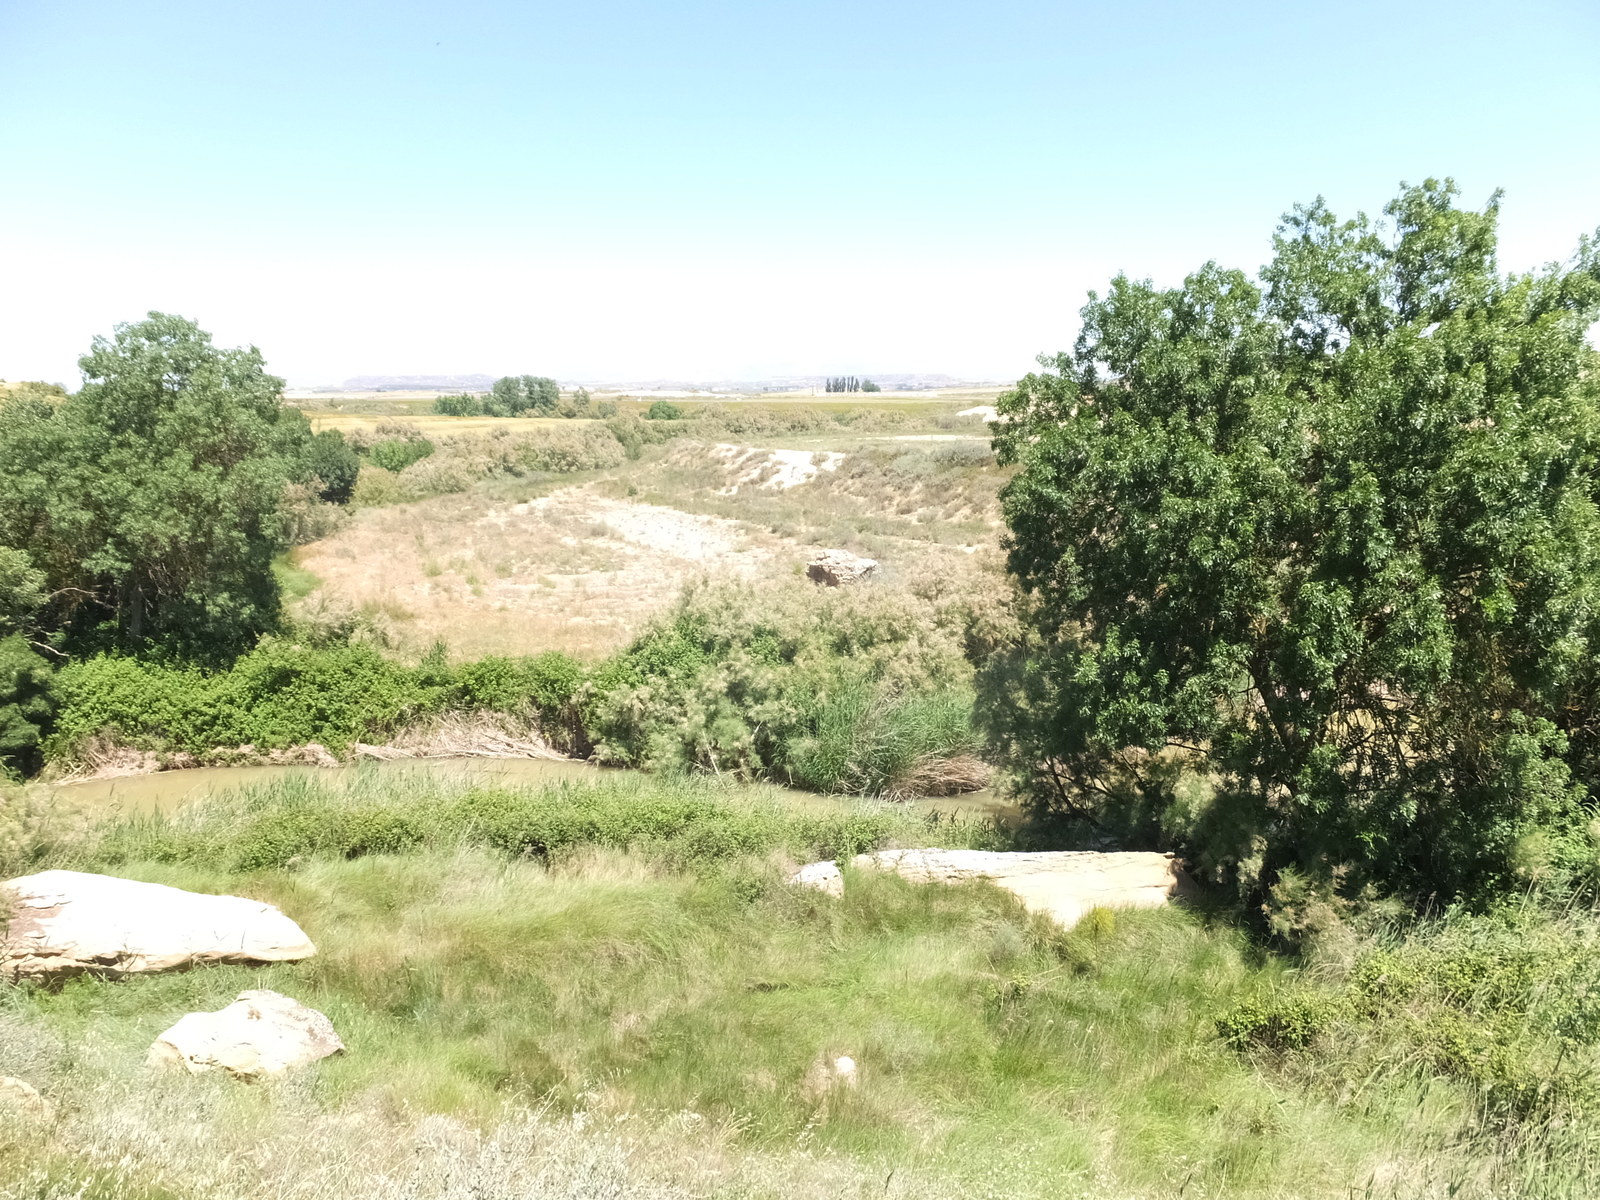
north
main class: Grassland
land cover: Spontaneously vegetated surfaces
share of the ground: > 75 %
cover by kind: herbaceous plants 80 %, consolidated bare surface 15 %, shrubs 5 %
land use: Semi-natural and natural areas not in use
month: May
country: ES
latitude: 41.8089
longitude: -0.2137
